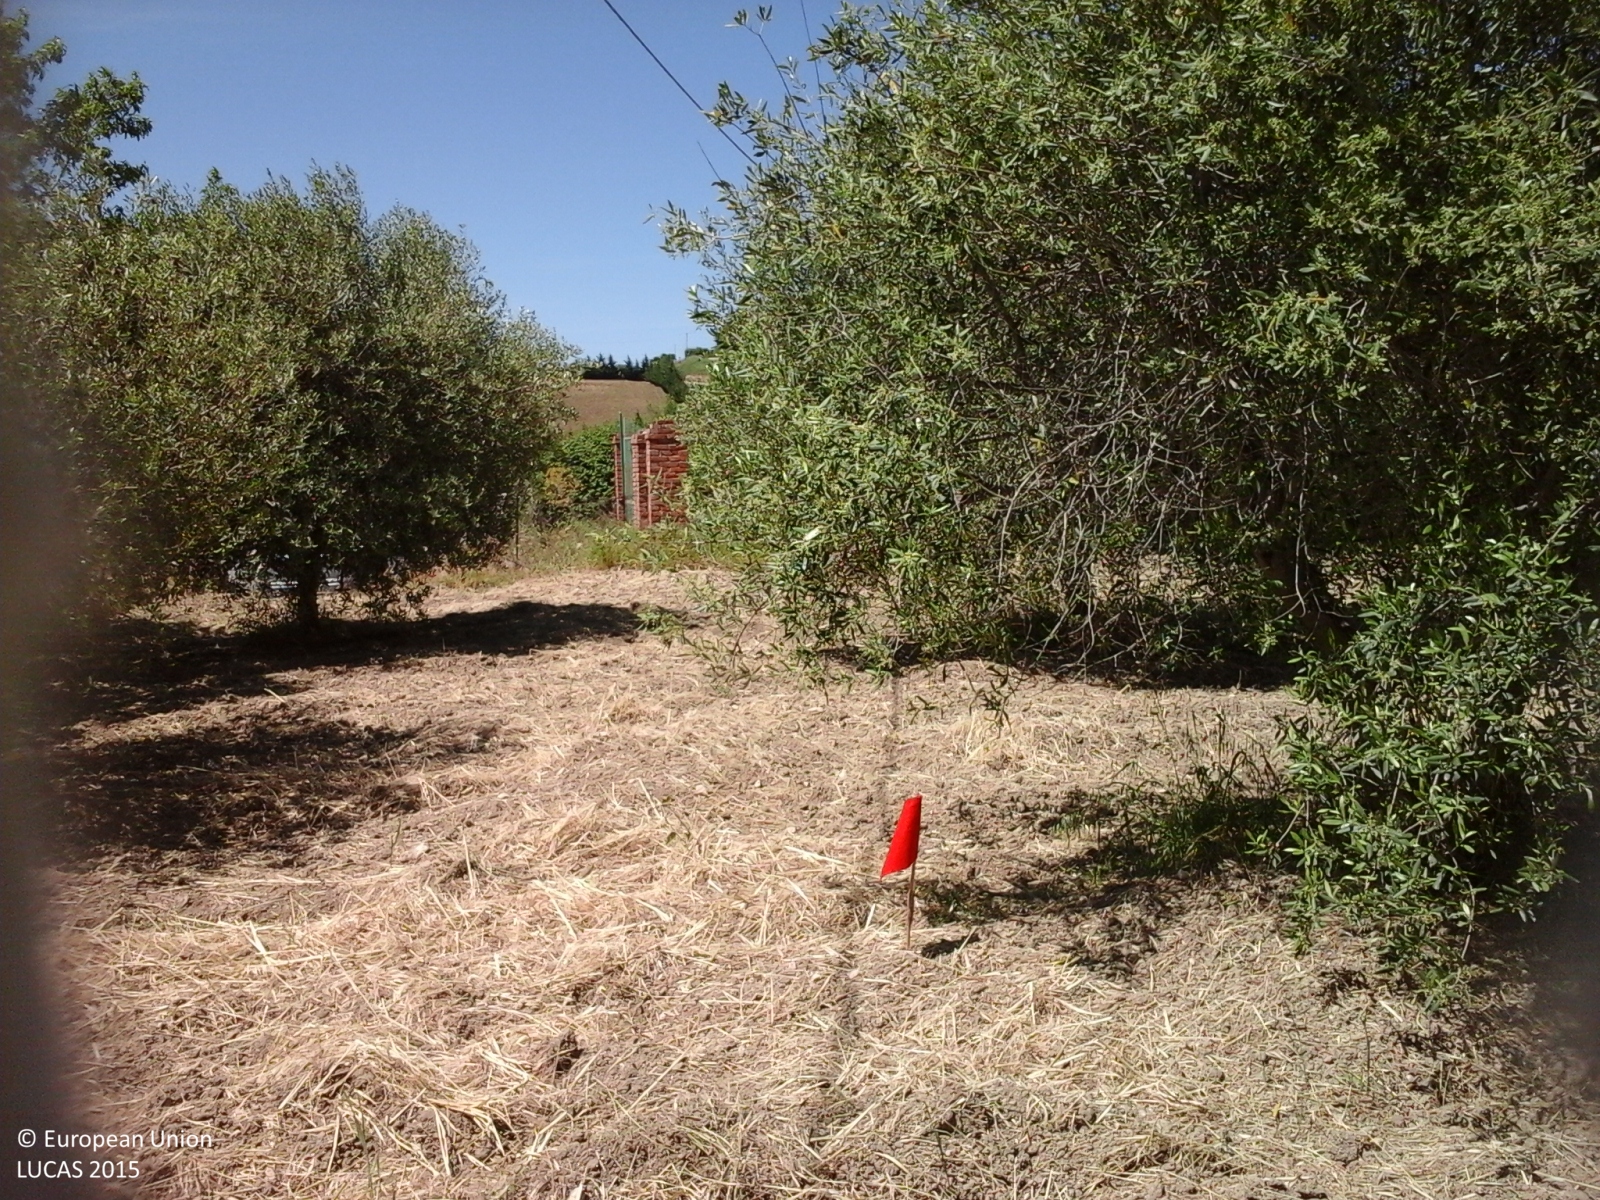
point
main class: Cropland
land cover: Olive groves
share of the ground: > 75 %
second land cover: Other bare soil
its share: > 75 %
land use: Agriculture (excluding fallow land and kitchen gardens)
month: May
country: IT
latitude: 37.4641
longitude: 13.9837
